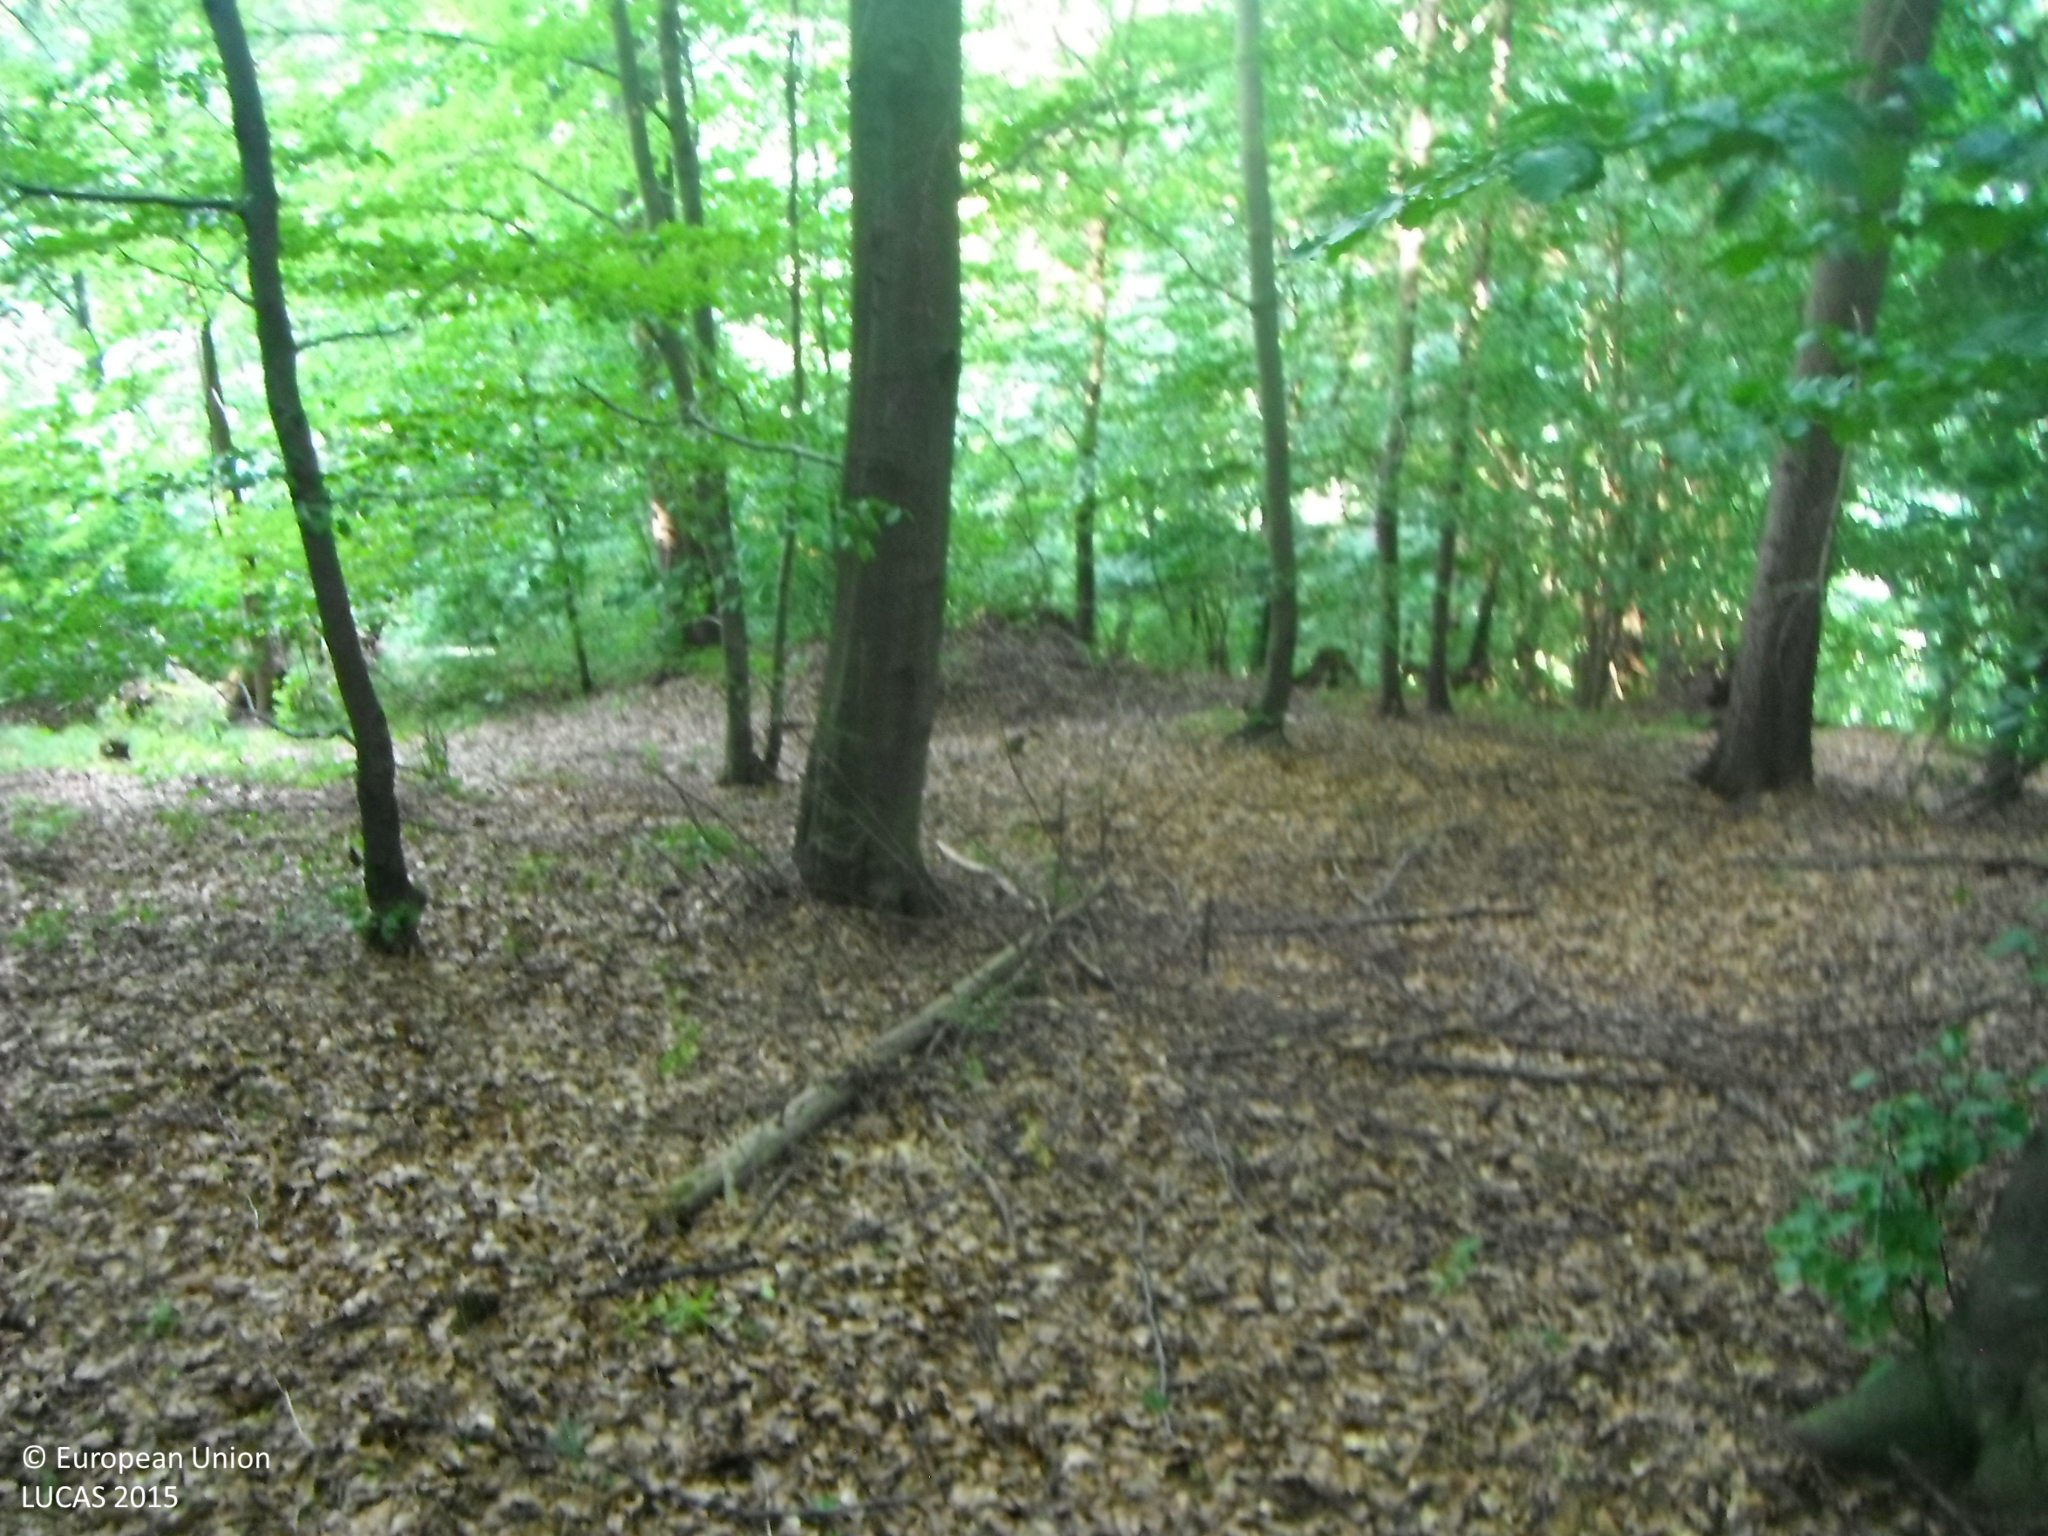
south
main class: Woodland
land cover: Broadleaved woodland
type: beech forest
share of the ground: > 75 %
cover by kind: broadleaved forest trees 100 %
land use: Forestry
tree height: > 5 m
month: August
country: SK
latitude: 48.7552
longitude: 20.3030
